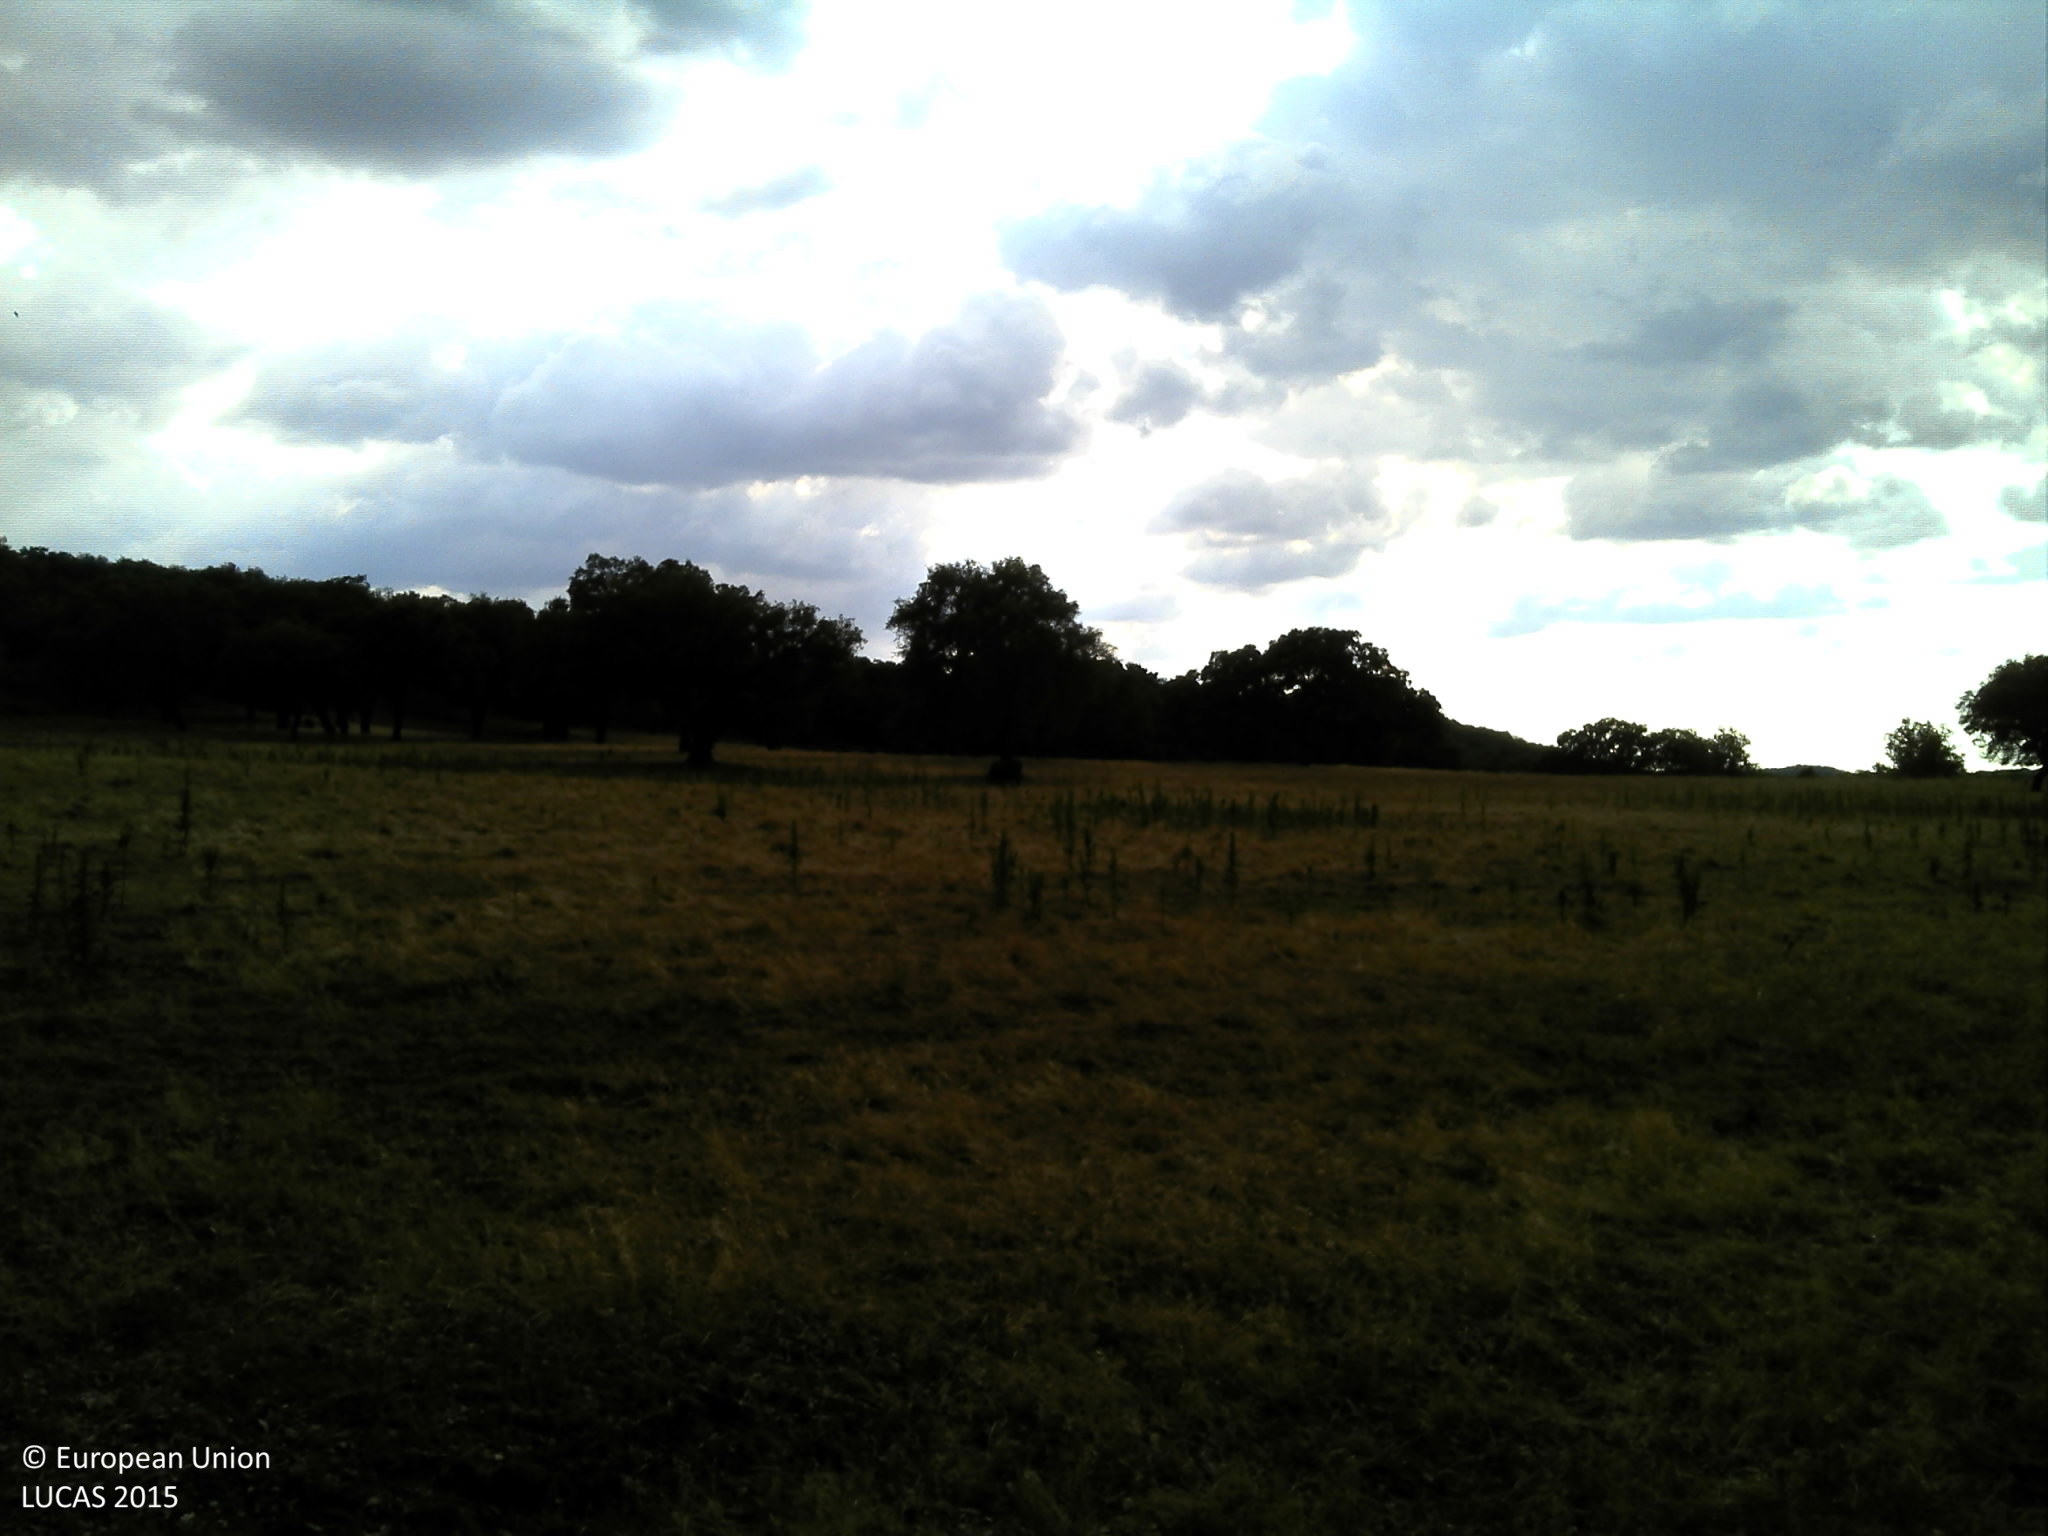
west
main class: Woodland
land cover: Broadleaved woodland
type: broadleaved evergreen forest
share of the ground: 25 - 50 %
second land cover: Grassland without tree/shrub cover
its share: < 10 %
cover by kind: unconsolidated bare surface 50 %, broadleaved forest trees 40 %, herbaceous plants 10 %
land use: Forestry
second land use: Agriculture (excluding fallow land and kitchen gardens)
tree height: > 5 m
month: June
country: PT
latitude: 38.5773
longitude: -8.1474
